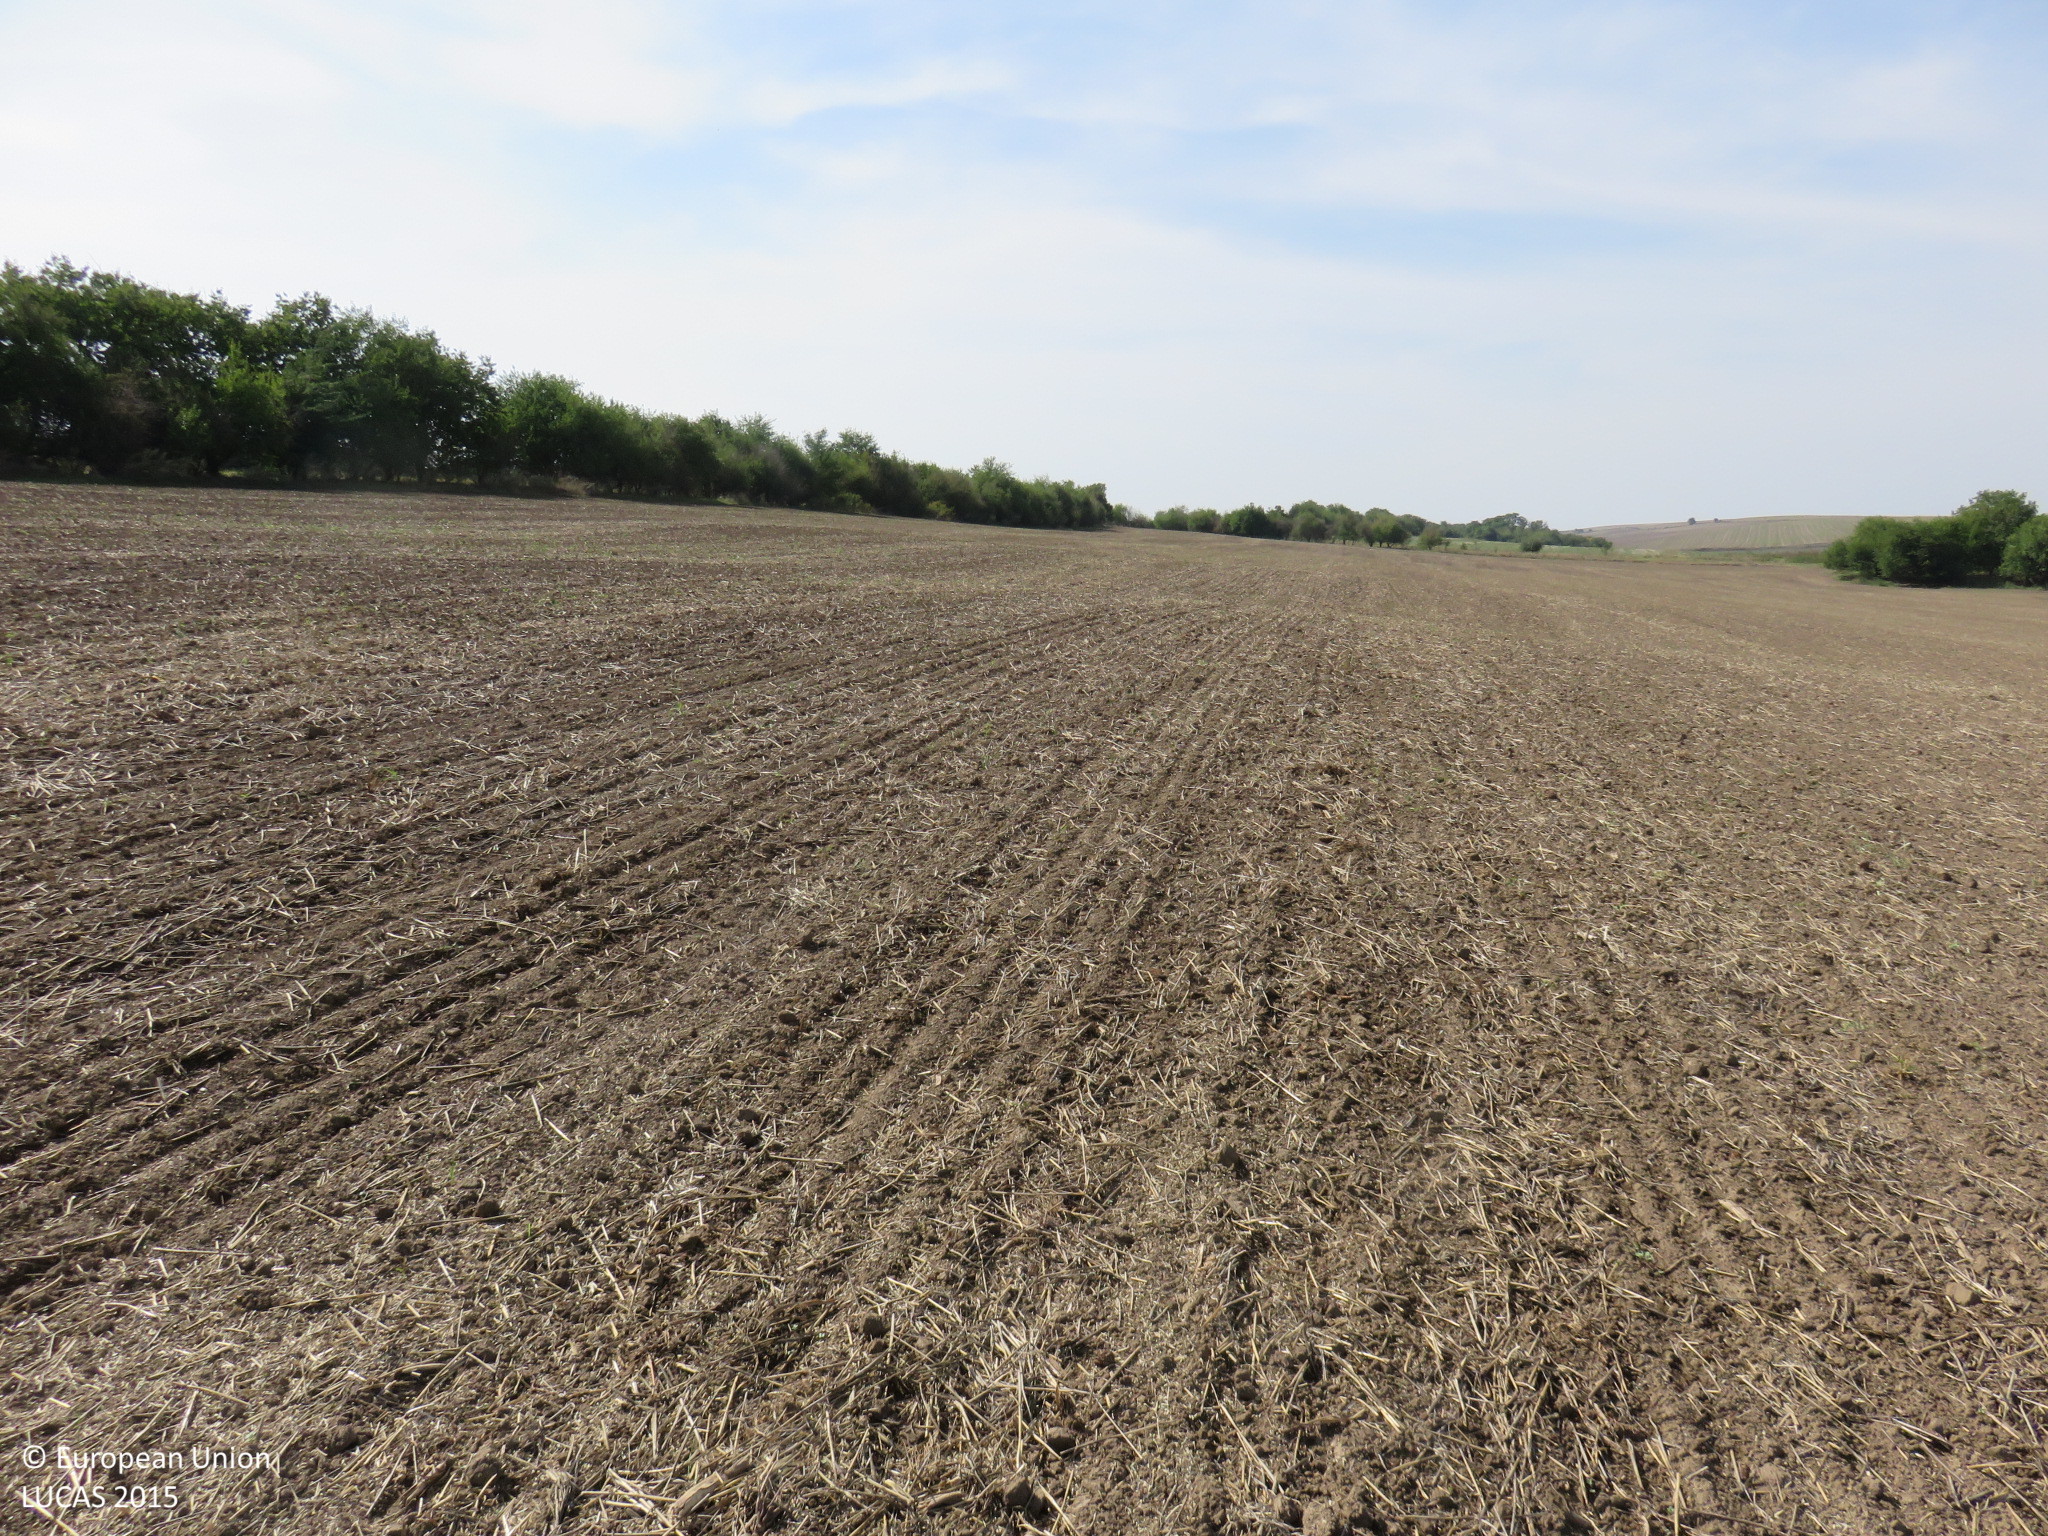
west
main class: Cropland
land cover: Common wheat
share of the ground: < 10 %
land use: Agriculture (excluding fallow land and kitchen gardens)
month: September
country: BG
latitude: 43.6259
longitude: 24.5768
